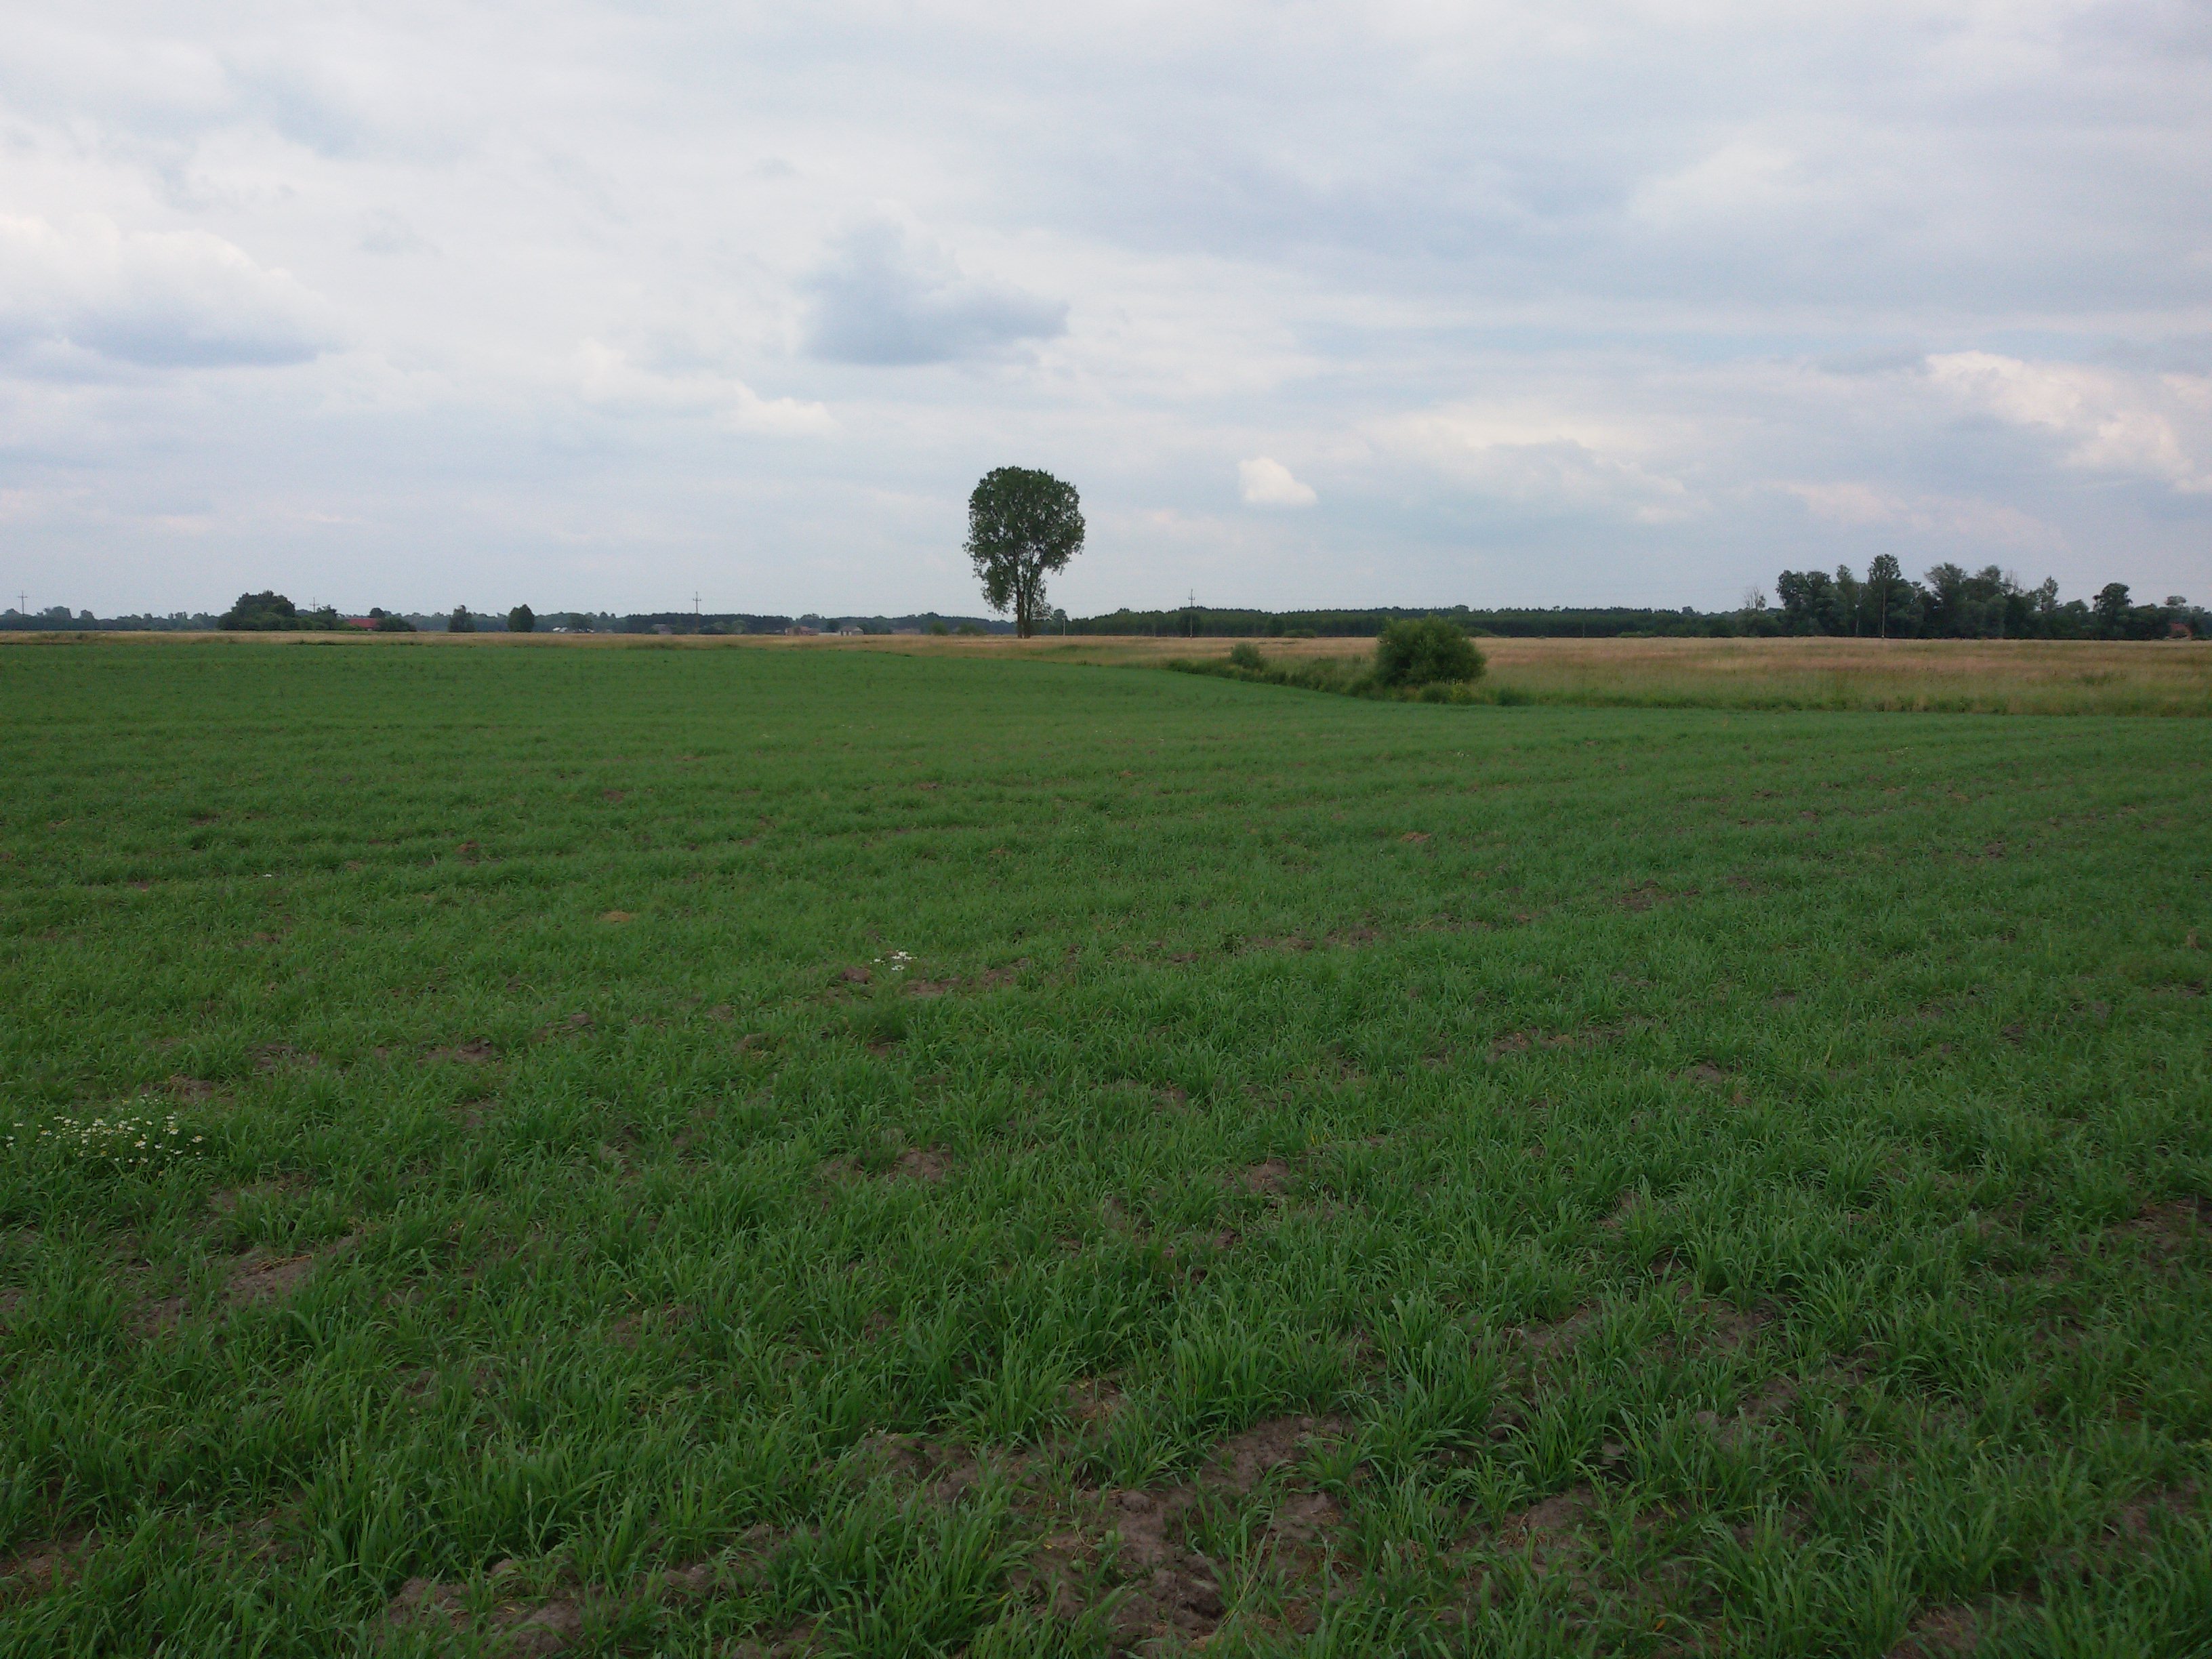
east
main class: Grassland
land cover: Grassland without tree/shrub cover
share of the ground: > 75 %
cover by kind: herbaceous plants 100 %
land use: Agriculture (excluding fallow land and kitchen gardens)
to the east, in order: Grassland without tree/shrub cover; Ditches and canals; Spontaneously vegetated surfaces
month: June
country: PL
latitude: 51.9862
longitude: 23.6439
